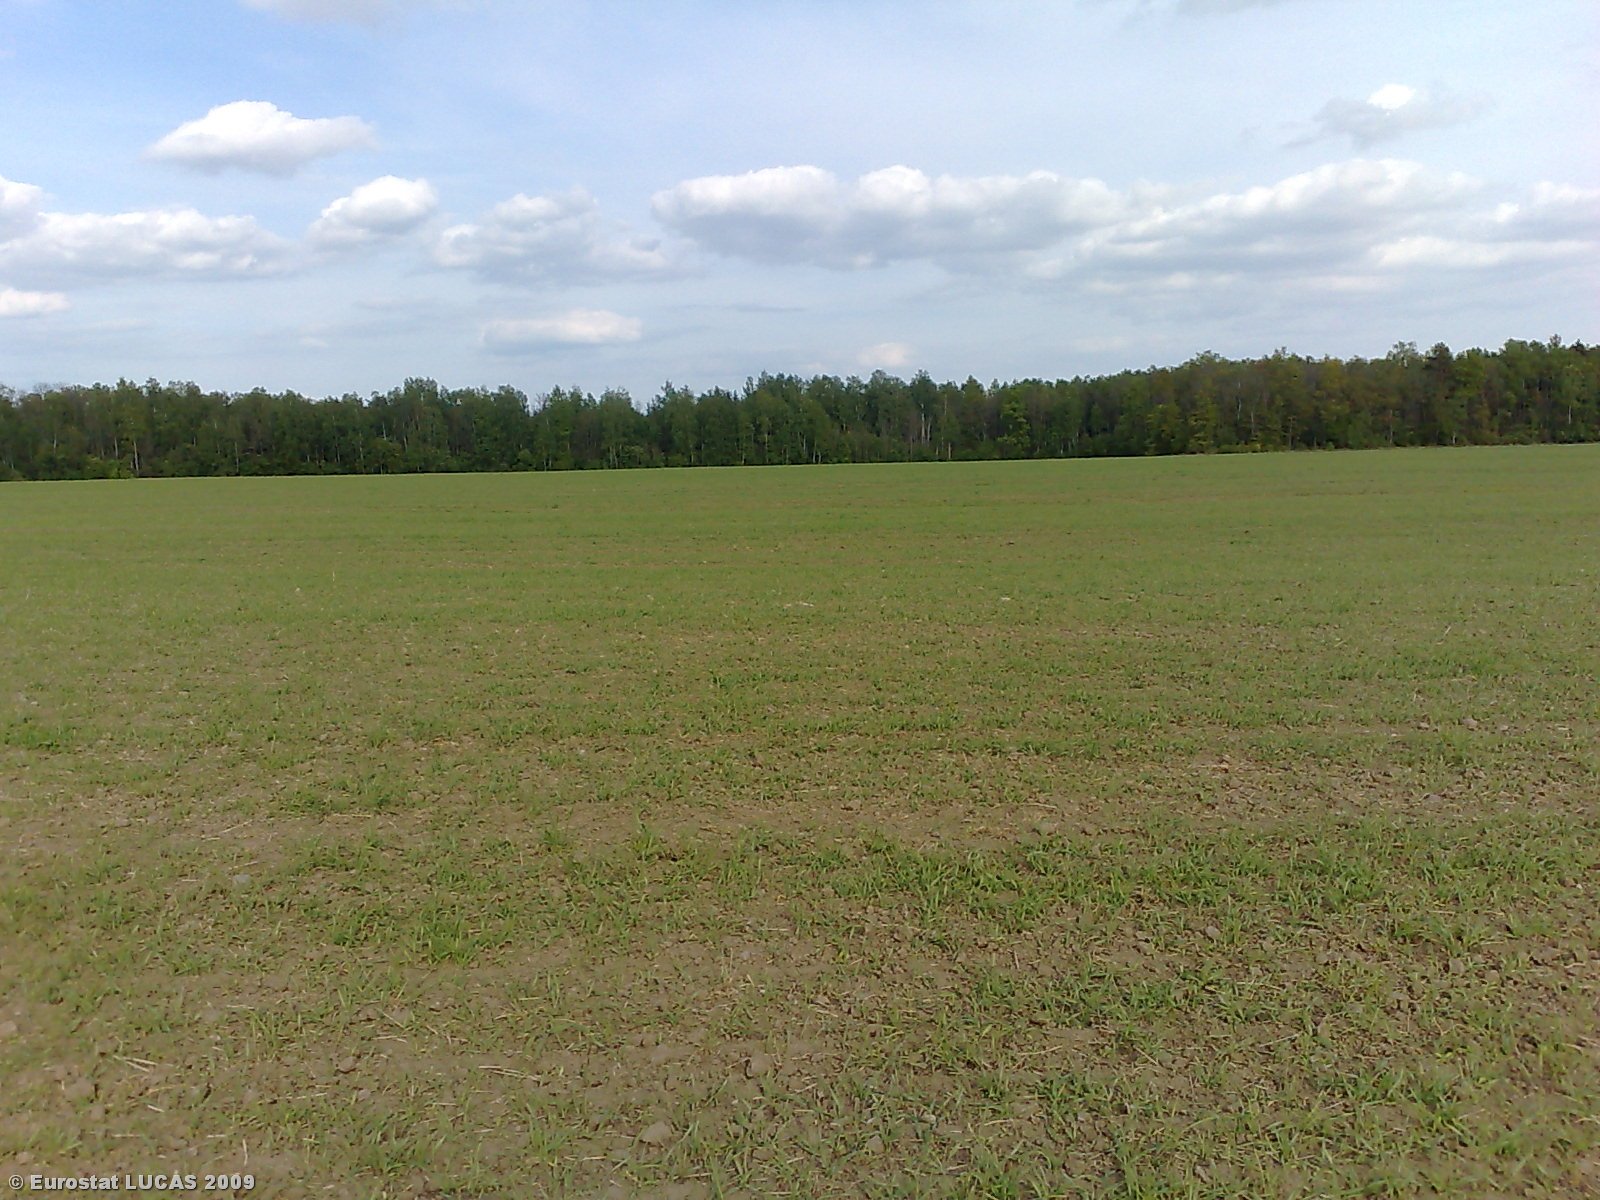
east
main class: Cropland
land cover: Barley
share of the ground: 50 - 75 %
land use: Agriculture (excluding fallow land and kitchen gardens)
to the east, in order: Barley
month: May
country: LT
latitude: 55.8533
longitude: 23.8383
